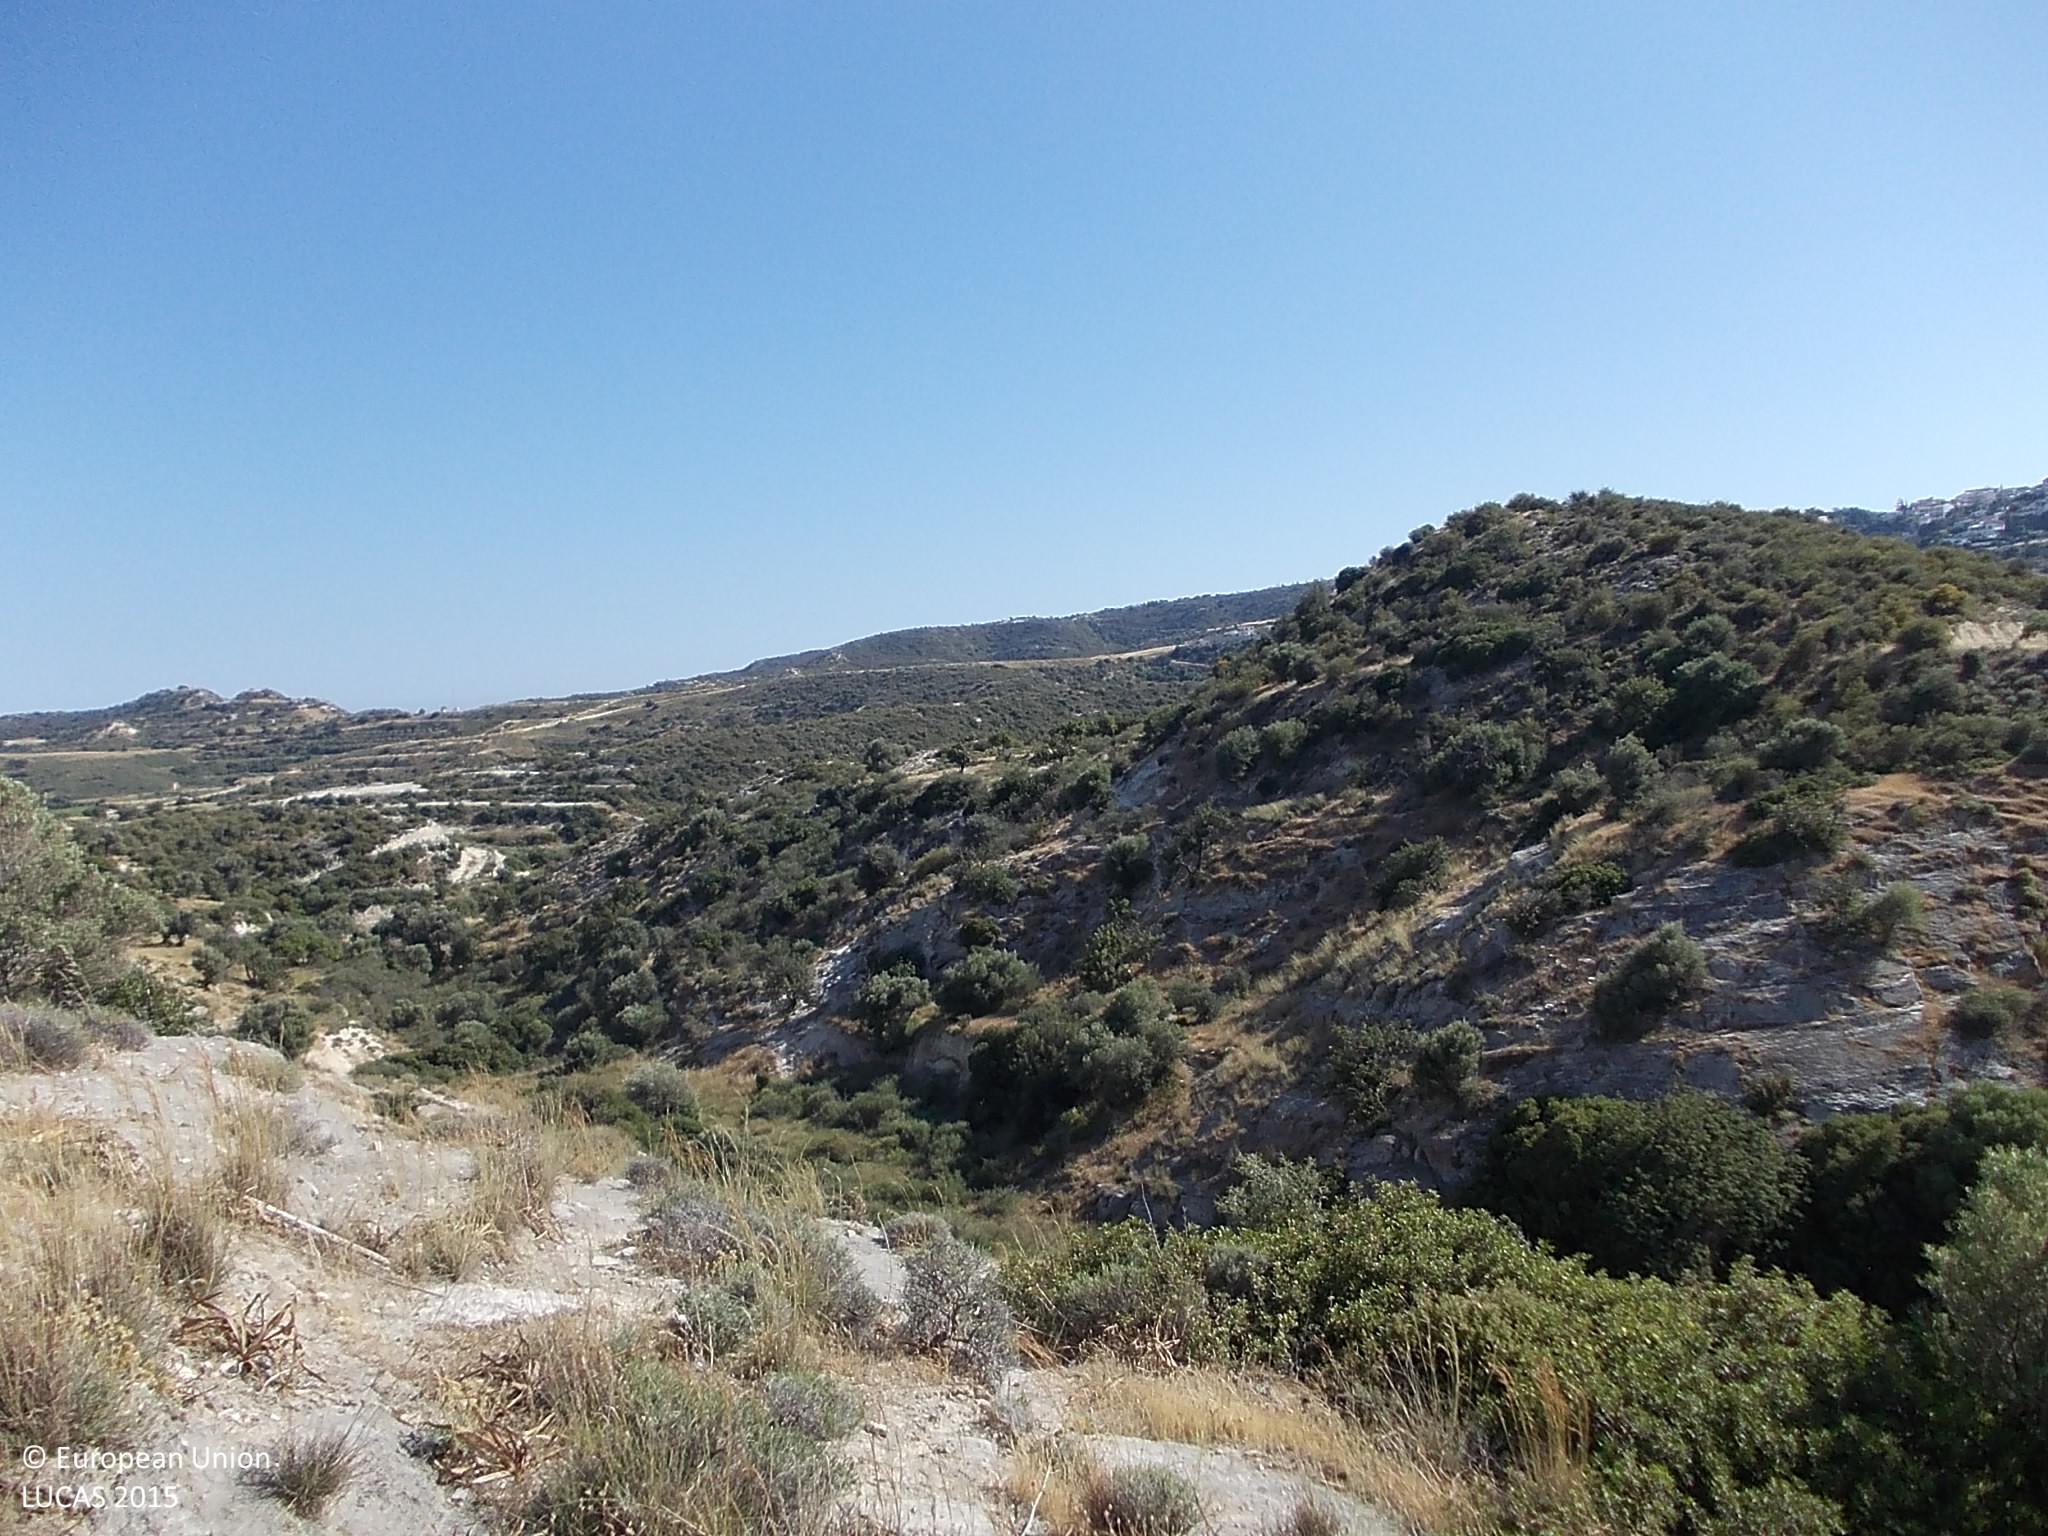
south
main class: Shrubland
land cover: Shrubland without tree cover
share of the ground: 25 - 50 %
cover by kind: shrubs 40 %, herbaceous plants 30 %, consolidated bare surface 30 %
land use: Semi-natural and natural areas not in use
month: May
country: CY
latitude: 34.6797
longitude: 32.7122
